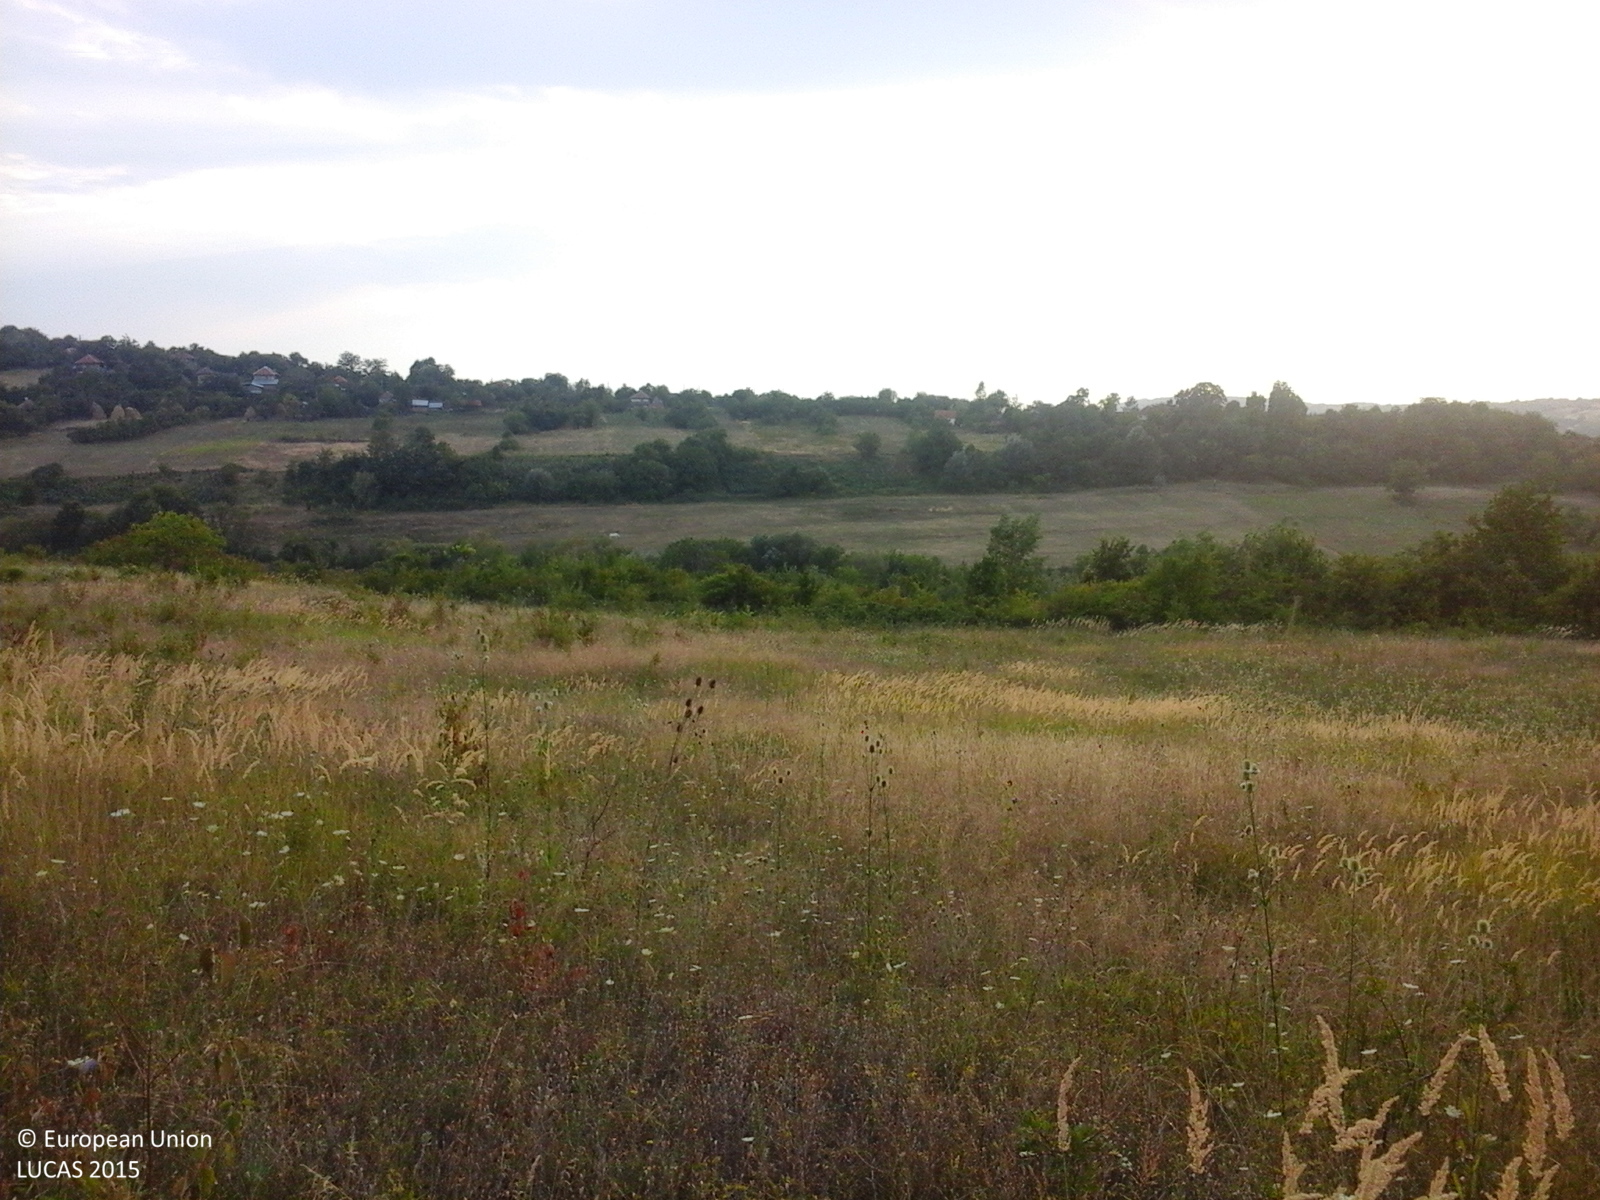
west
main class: Woodland
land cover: Broadleaved woodland
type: mesophytic deciduous forest
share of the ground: > 75 %
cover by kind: broadleaved forest trees 100 %
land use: Forestry
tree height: > 5 m
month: August
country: RO
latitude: 44.5655
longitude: 23.0278
